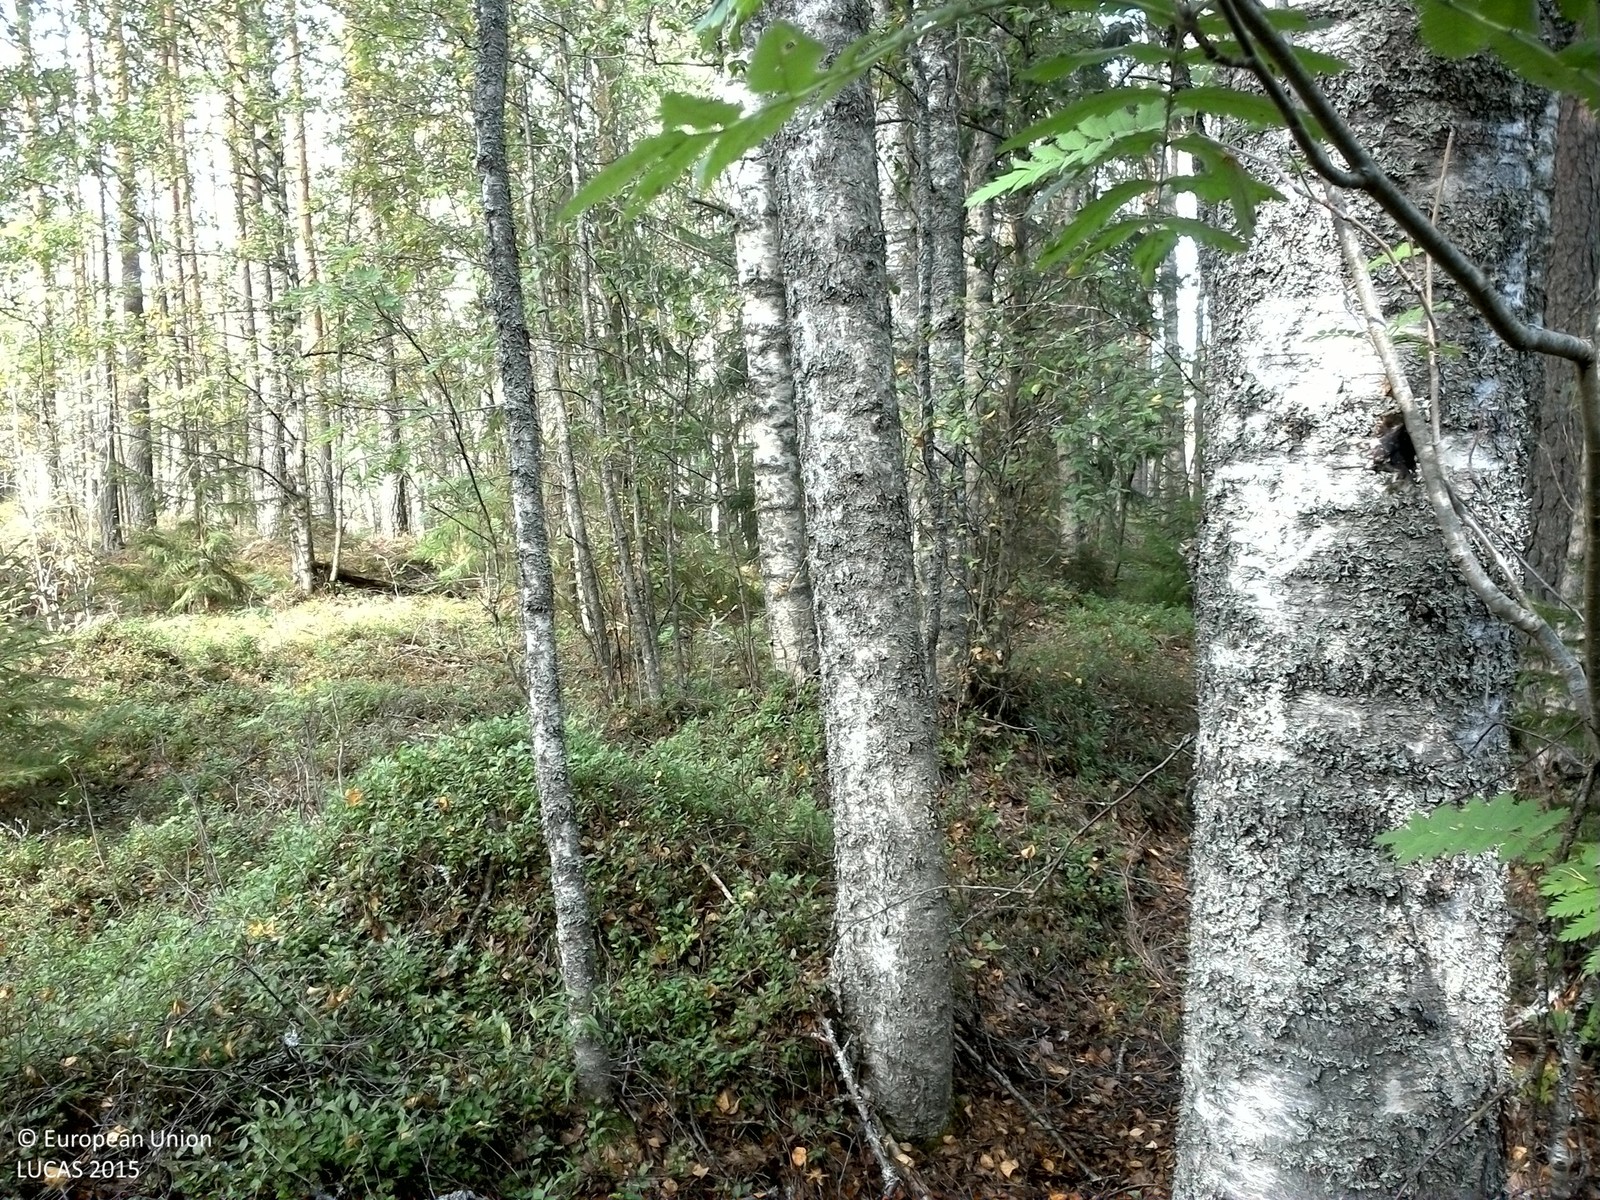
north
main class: Woodland
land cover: Pine dominated mixed woodland
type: boreal forest
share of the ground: 50 - 75 %
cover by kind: coniferous forest trees 50 %, broadleaved forest trees 20 %, shrubs 20 %, lichens and mosses 10 %
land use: Forestry
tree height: > 5 m
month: September
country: SE
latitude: 59.7948
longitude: 13.5018
